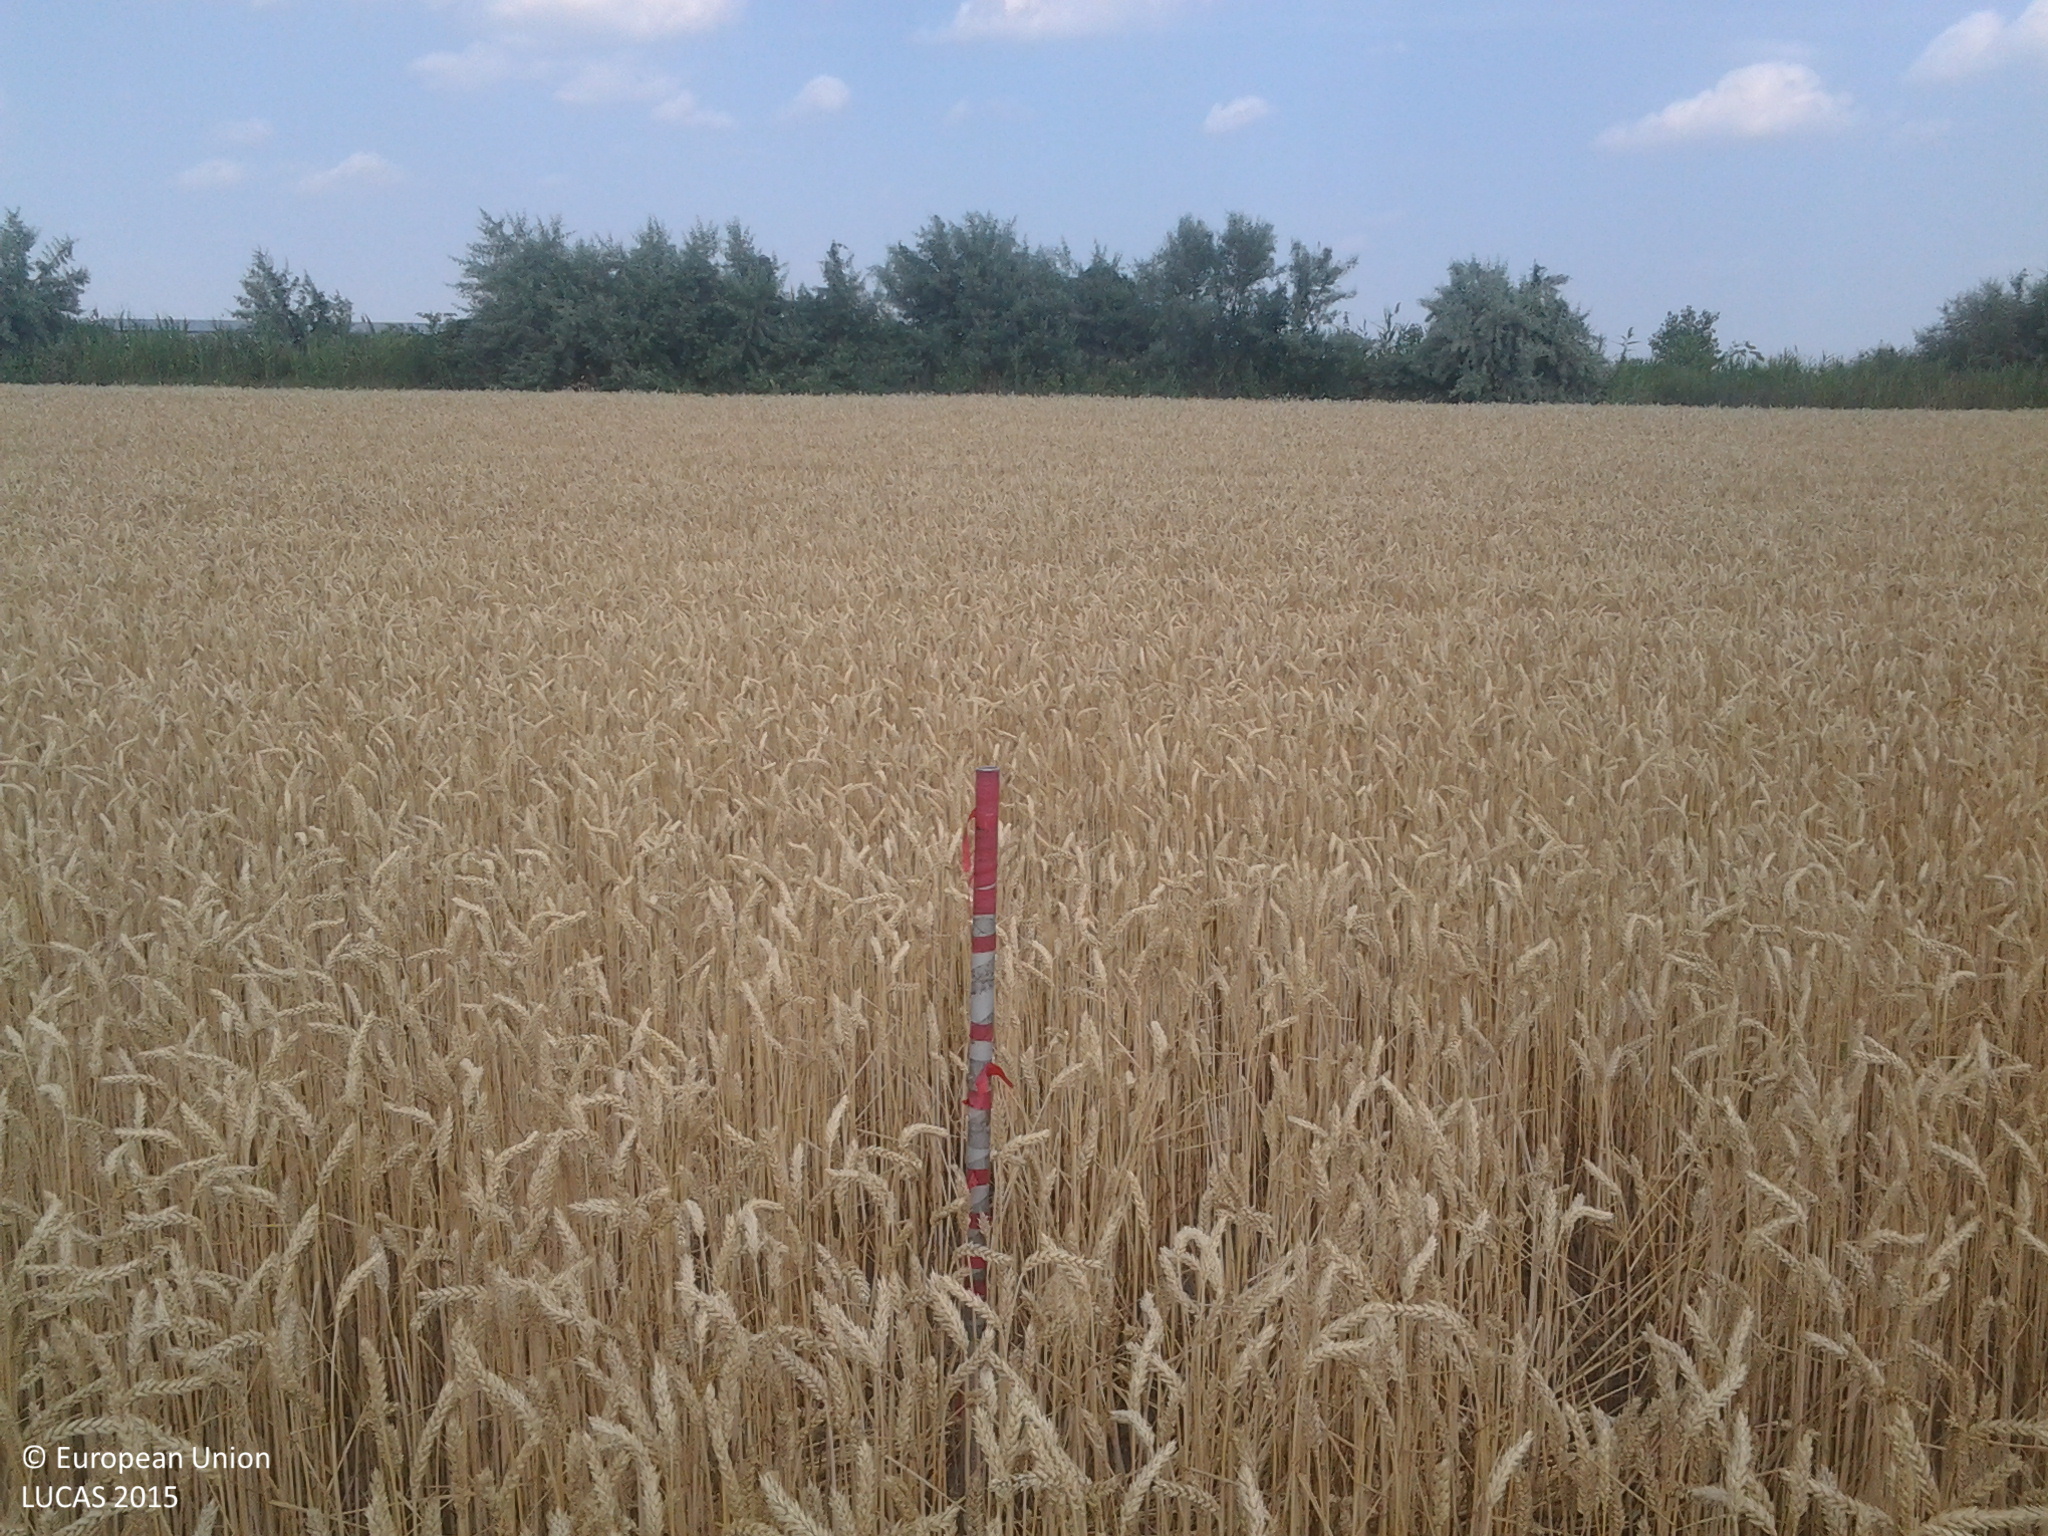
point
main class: Cropland
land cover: Common wheat
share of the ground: > 75 %
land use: Agriculture (excluding fallow land and kitchen gardens)
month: July
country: HU
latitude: 47.0933
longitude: 19.2263
